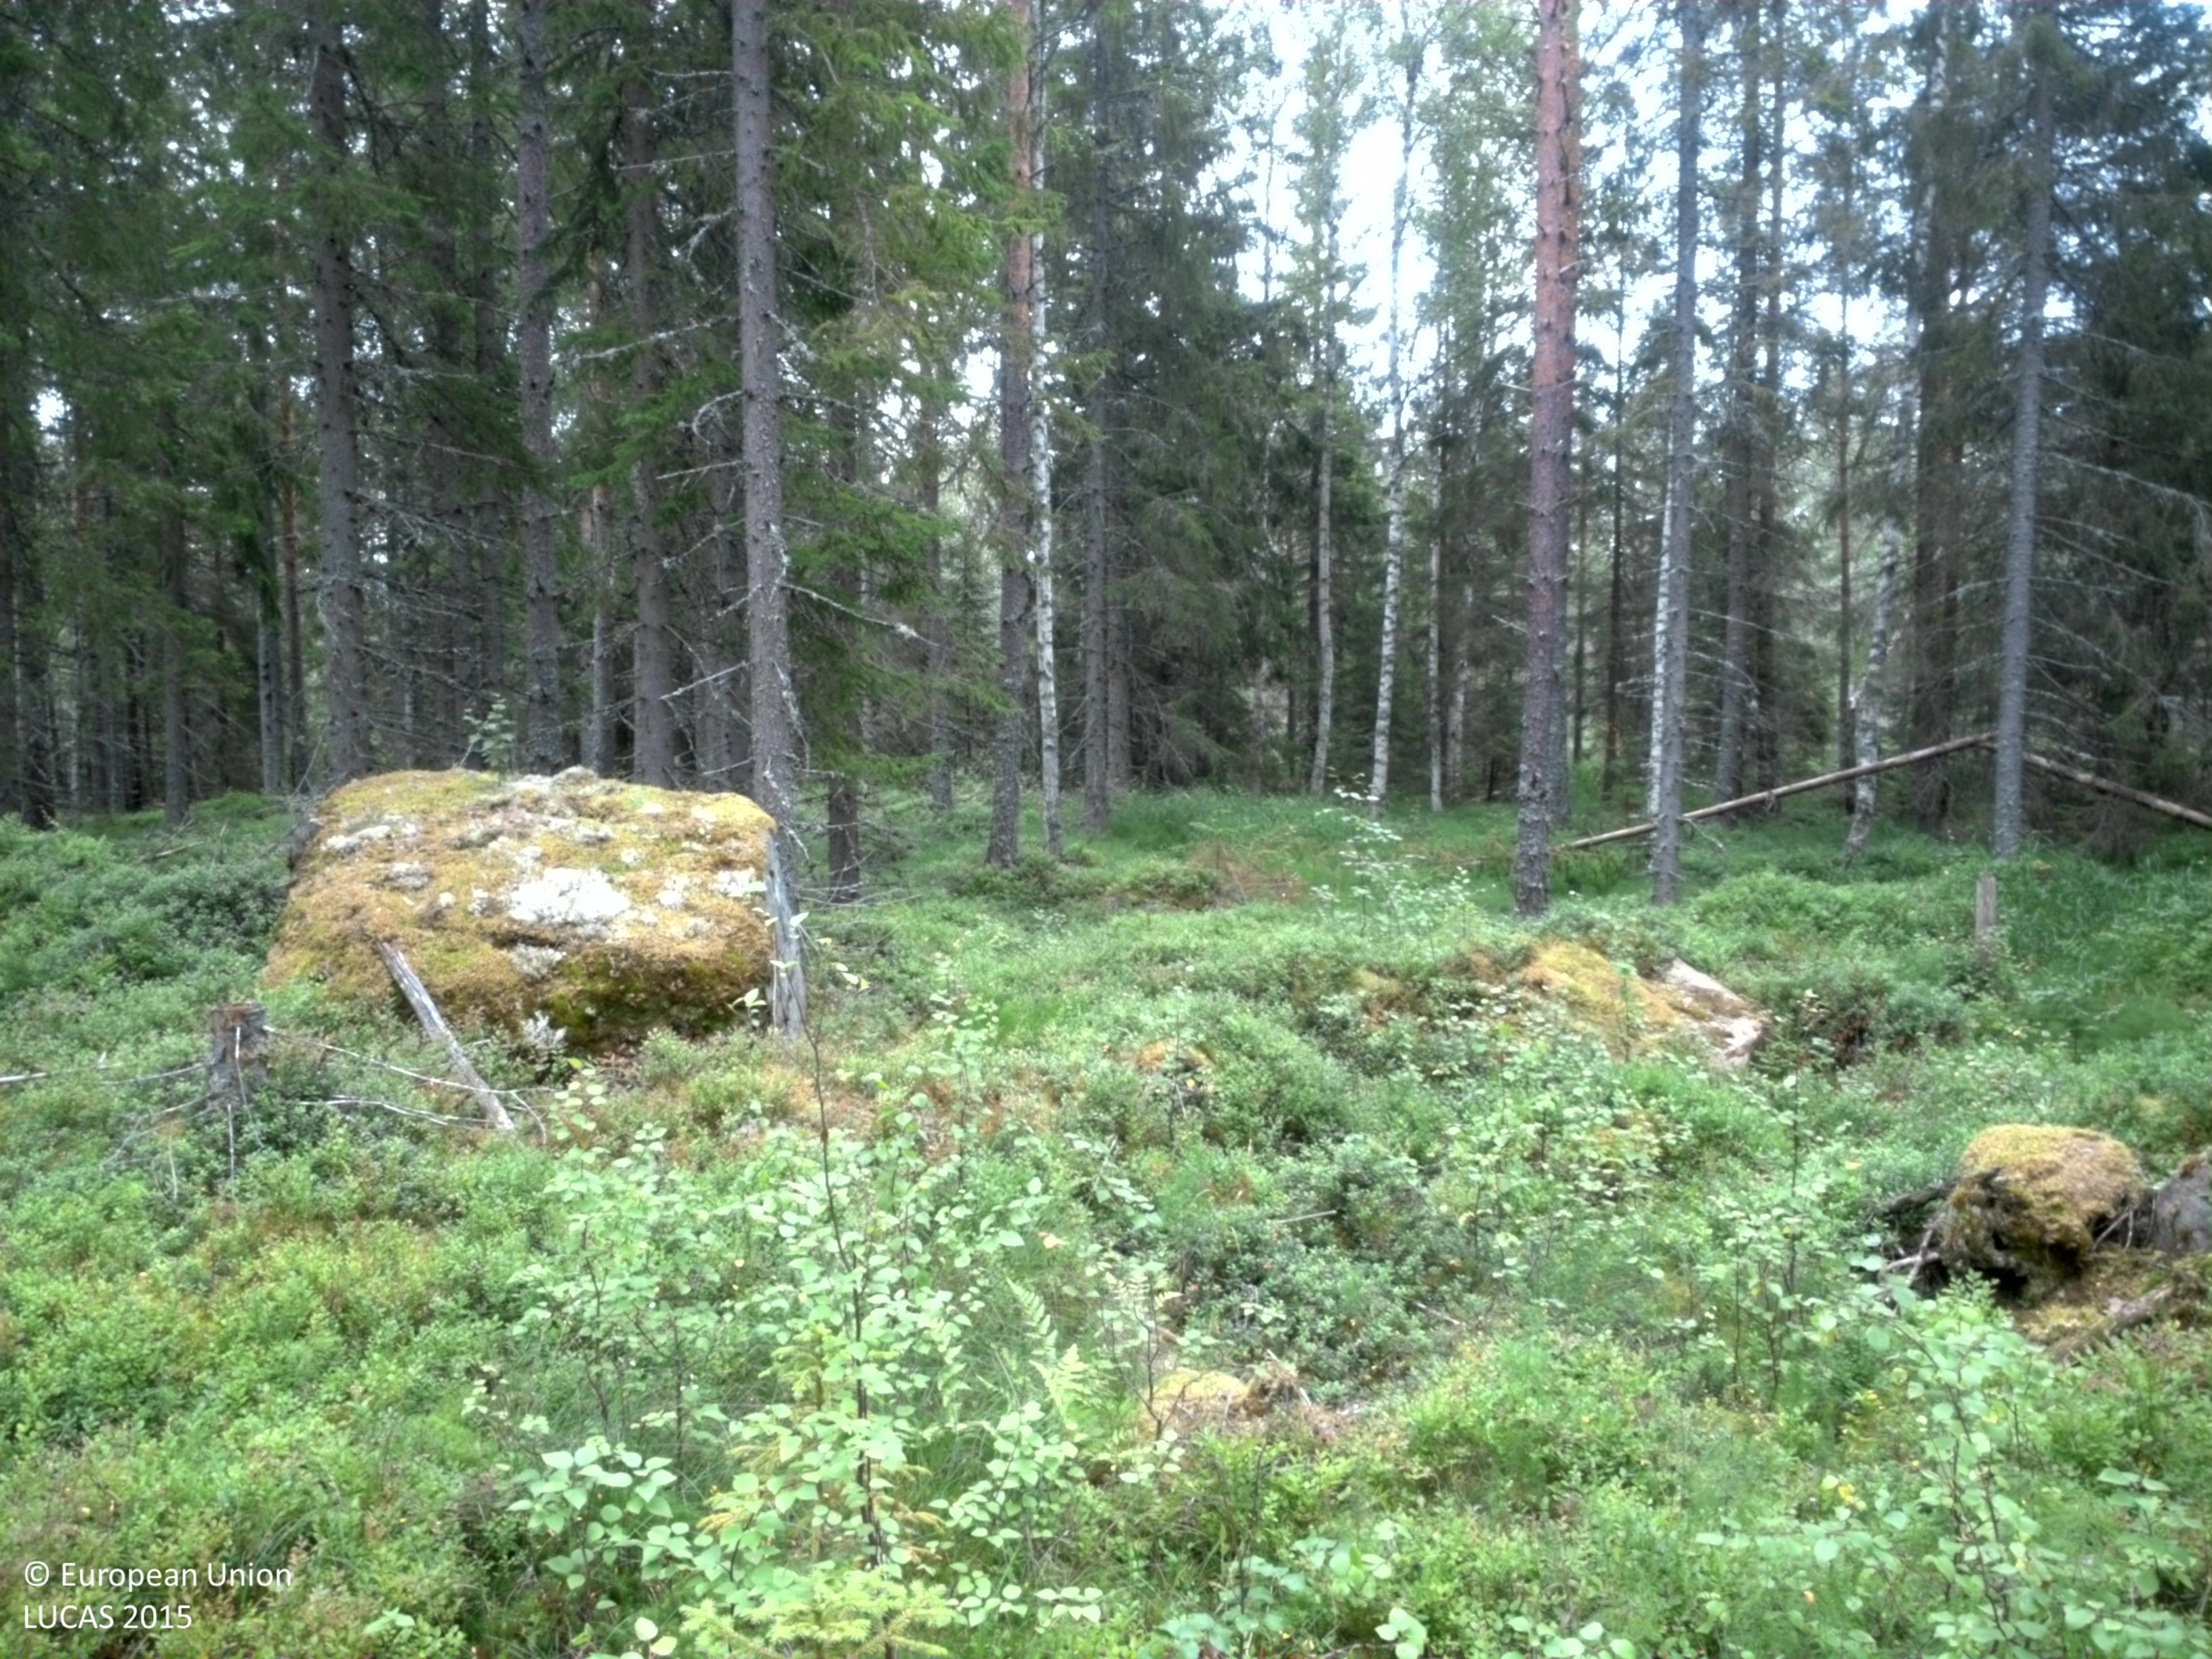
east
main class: Woodland
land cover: Spruce dominated mixed woodland
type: boreal forest
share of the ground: 50 - 75 %
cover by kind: coniferous forest trees 45 %, shrubs 20 %, broadleaved forest trees 15 %, herbaceous plants 15 %, lichens and mosses 5 %
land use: Forestry
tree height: > 5 m
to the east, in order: Spruce dominated mixed woodland; Pine dominated mixed woodland; Ditches and canals; Pine dominated mixed woodland; Paved roads, cycling and walking lanes; Pine dominated coniferous woodland; Spruce dominated mixed woodland
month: August
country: SE
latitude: 60.1926
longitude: 14.1195
